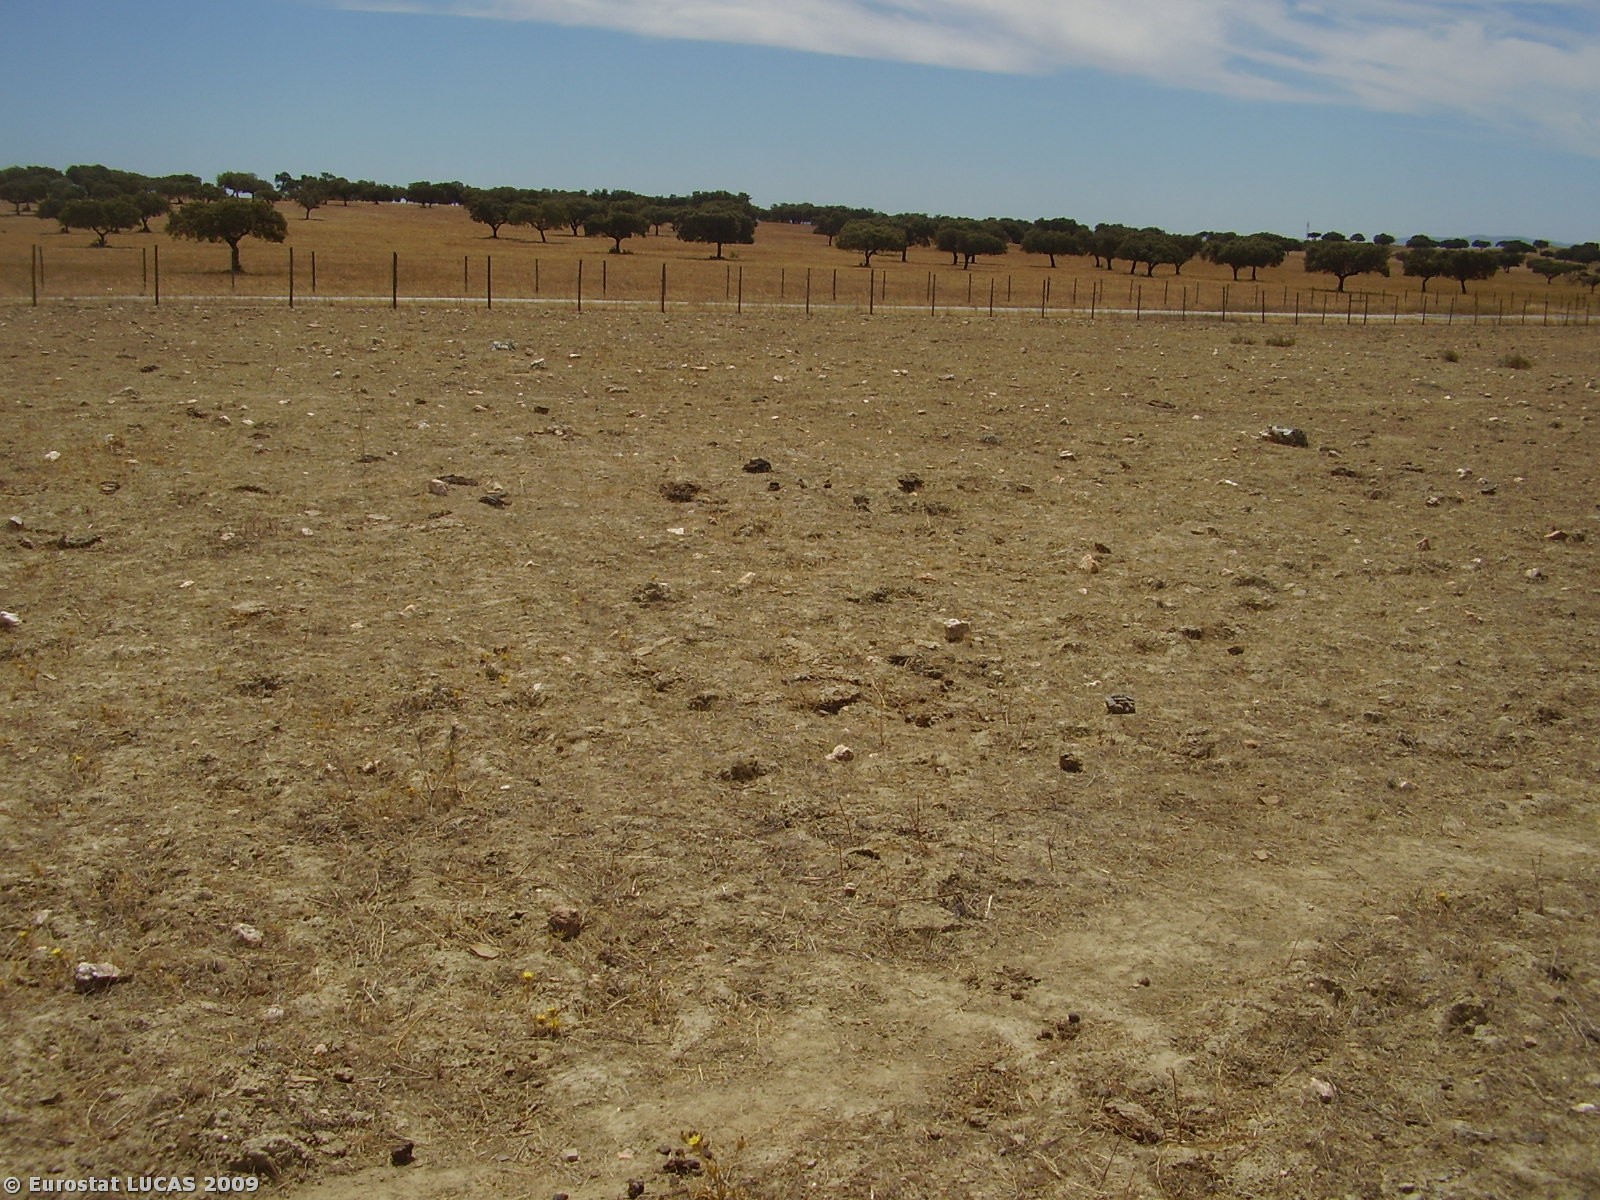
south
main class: Grassland
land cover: Grassland with sparse tree/shrub cover
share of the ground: > 75 %
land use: Fallow land
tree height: > 5 m
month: August
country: PT
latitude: 38.2255
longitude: -7.1621
